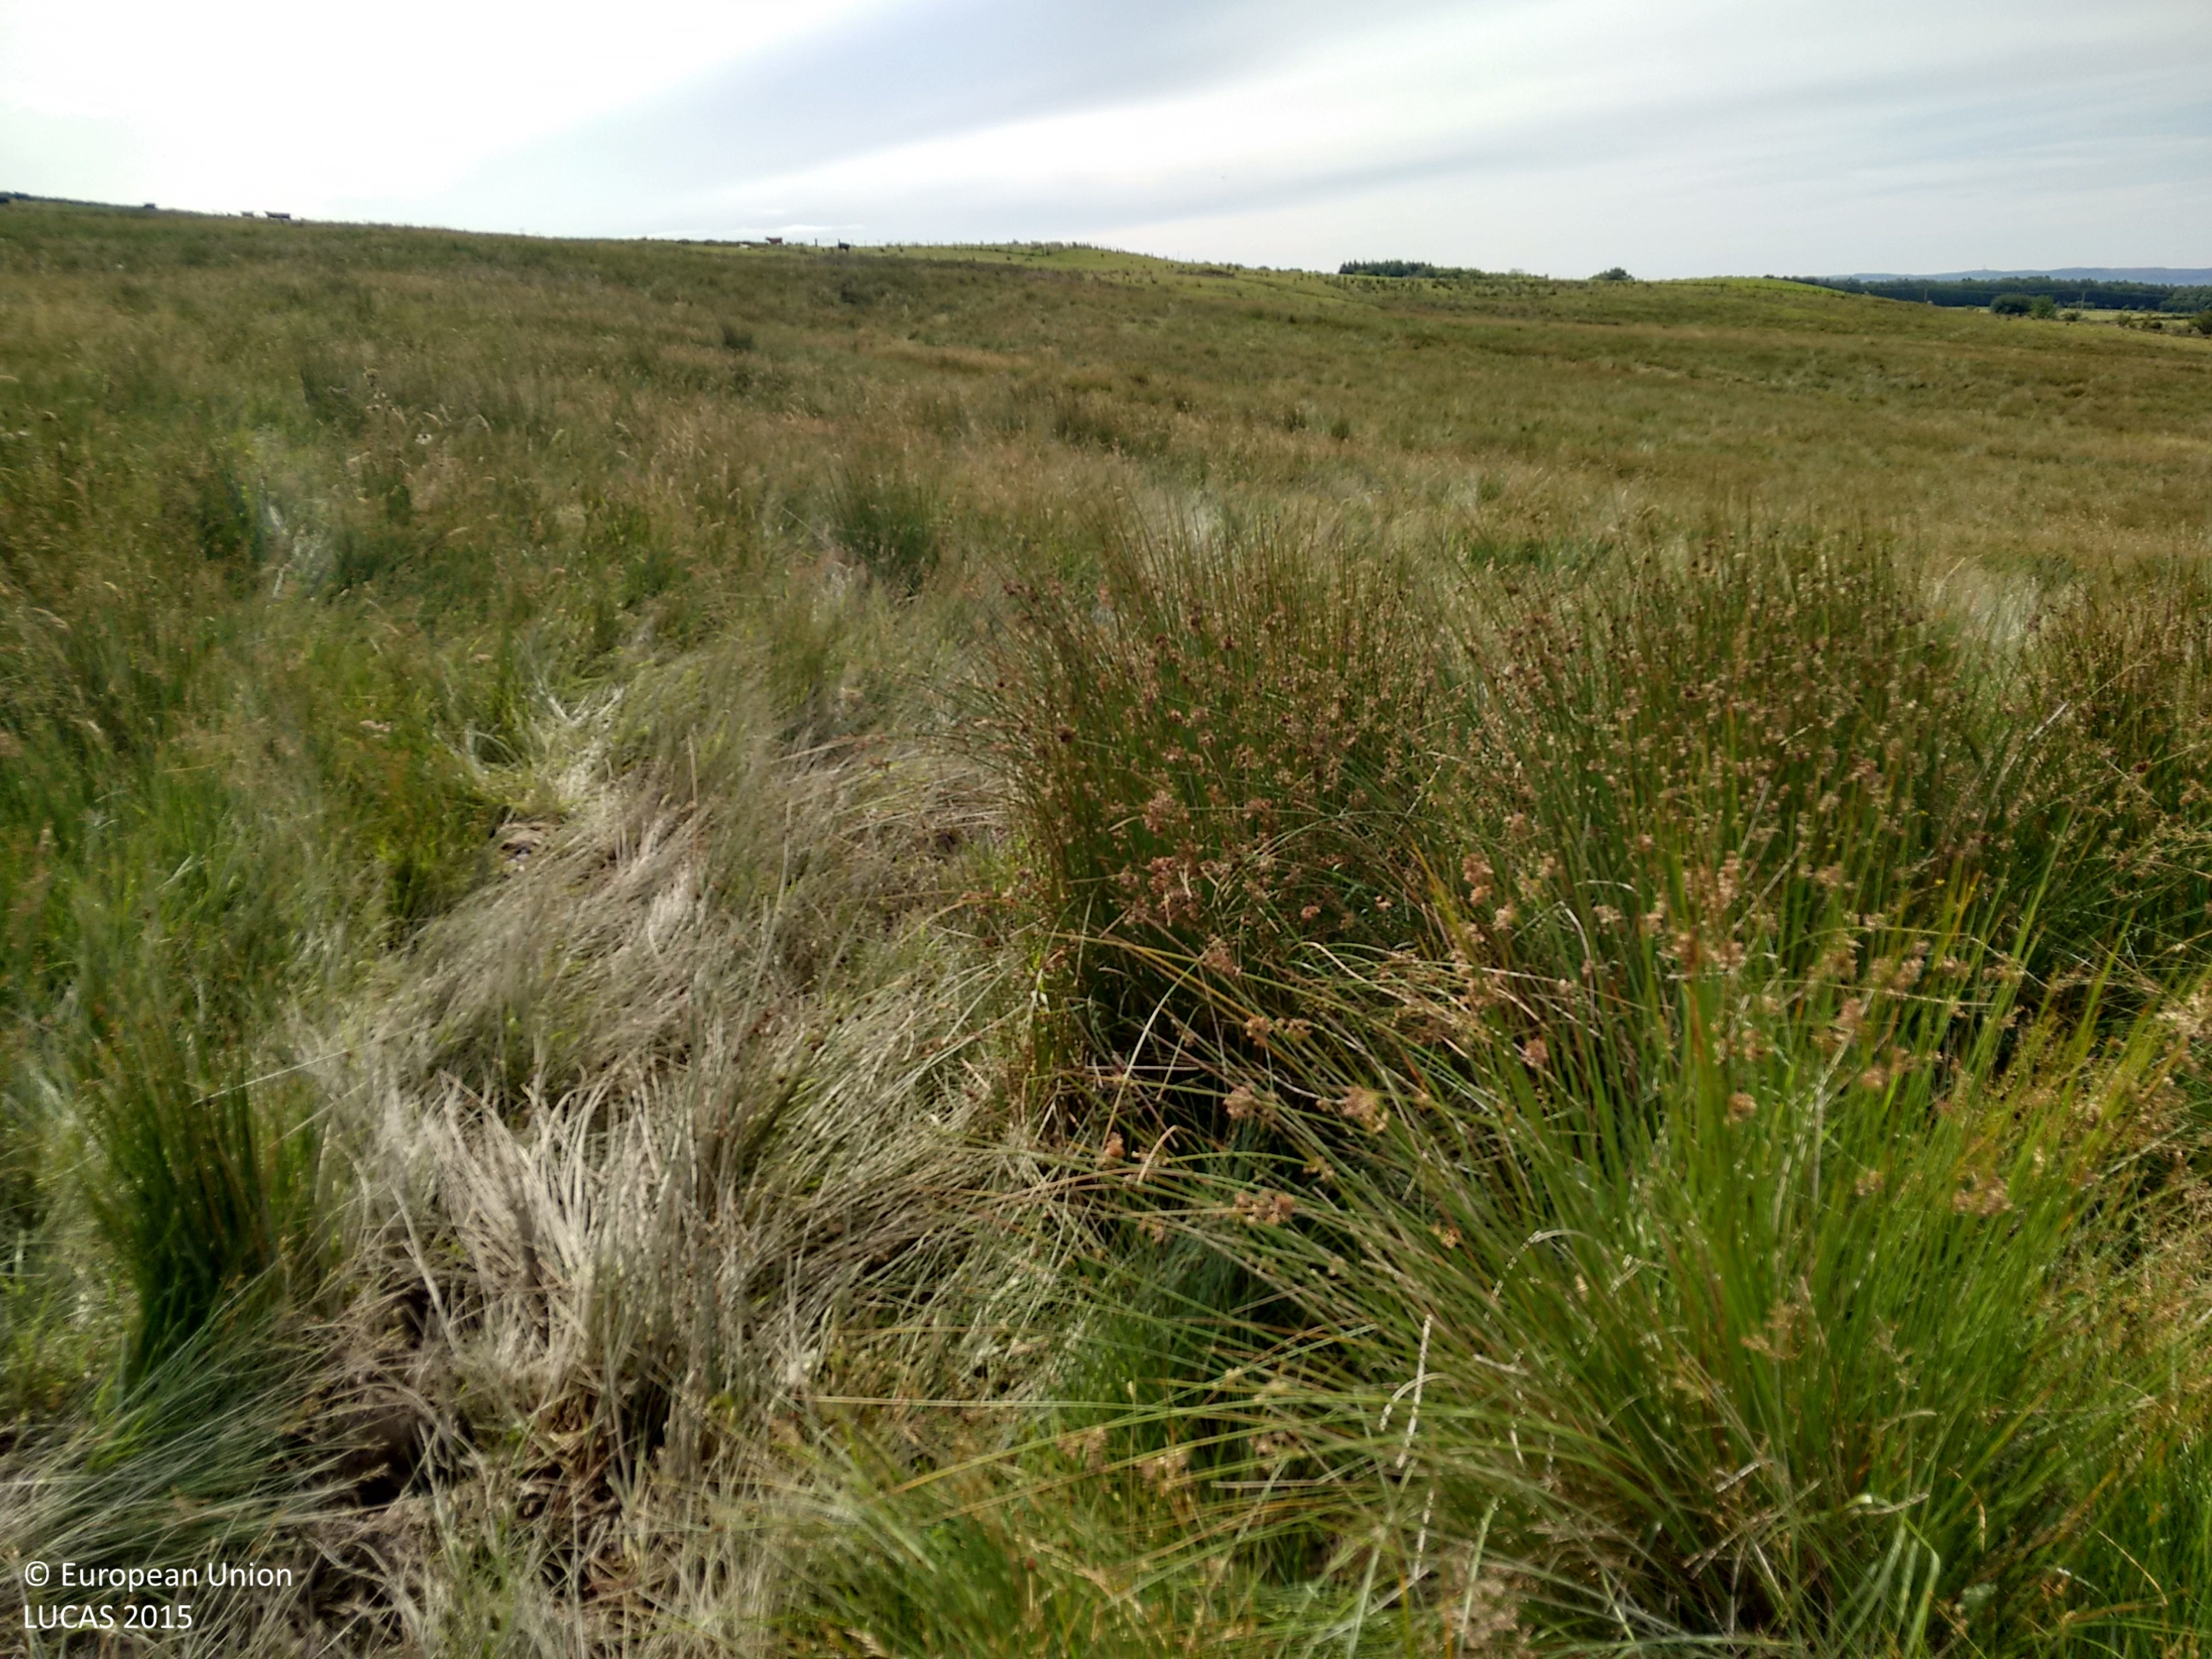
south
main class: Grassland
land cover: Grassland without tree/shrub cover
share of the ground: > 75 %
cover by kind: herbaceous plants 100 %
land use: Agriculture (excluding fallow land and kitchen gardens)
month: August
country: GB
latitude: 55.2082
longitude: -3.3880
